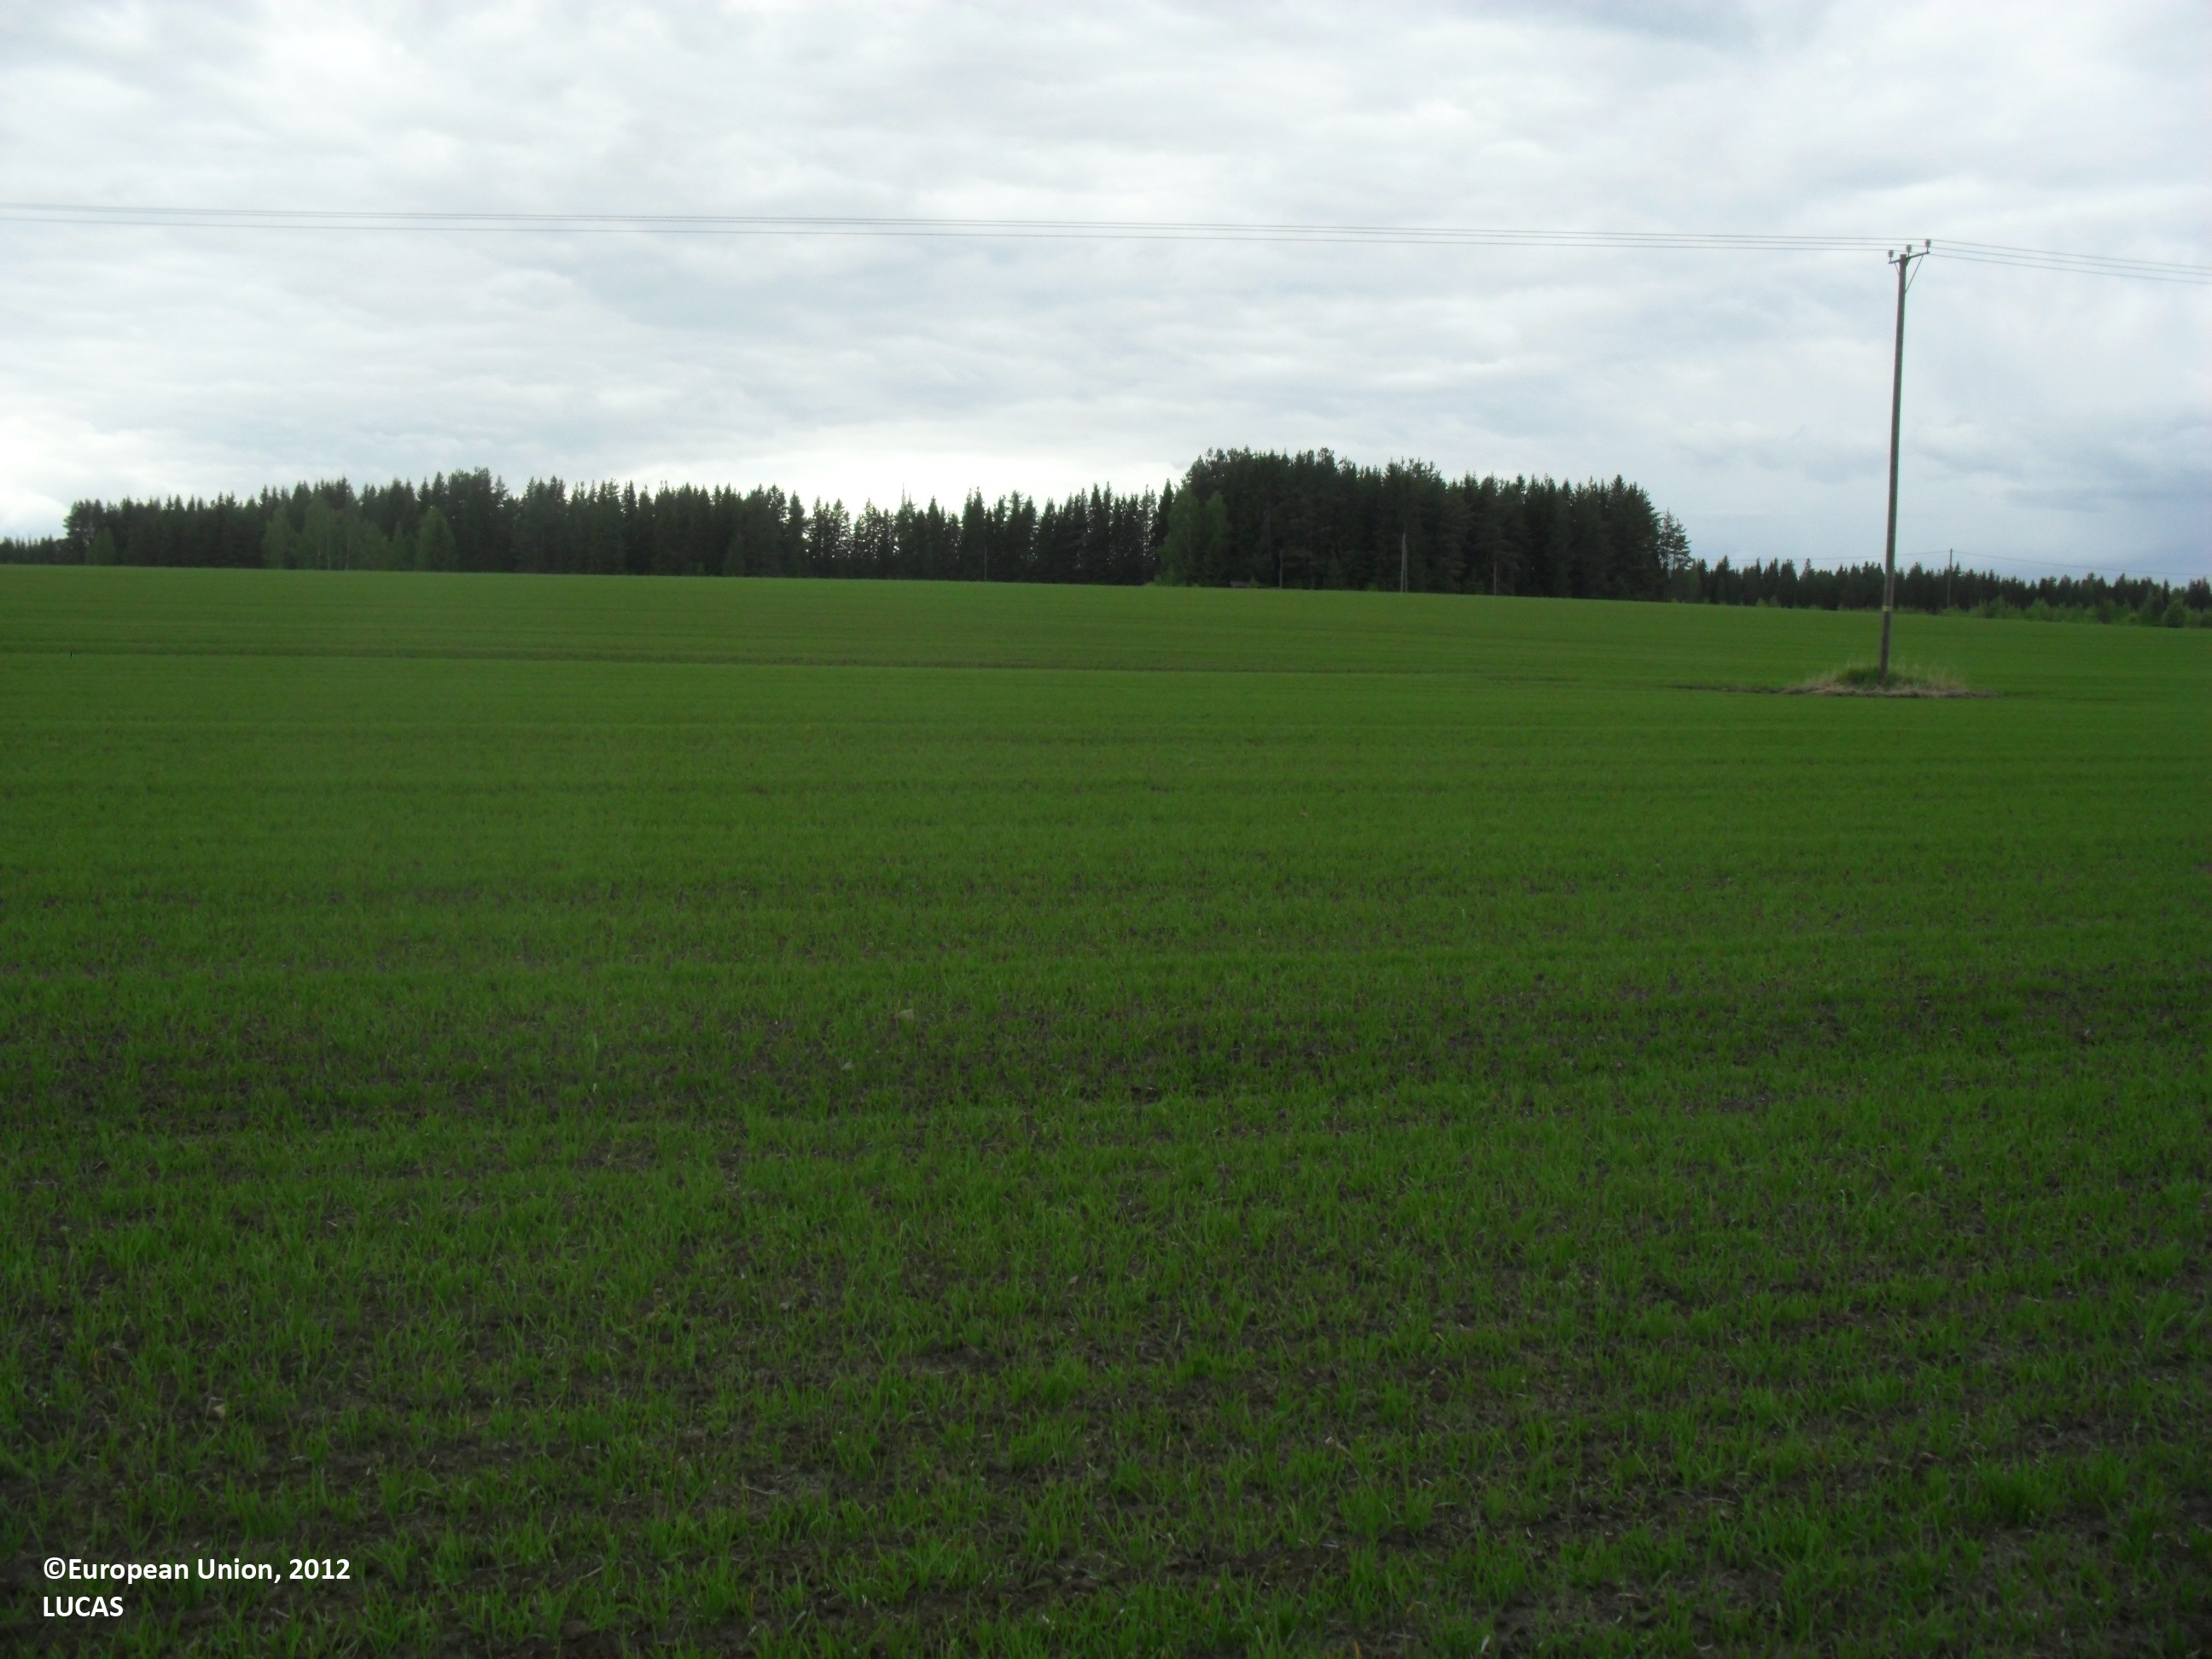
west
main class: Cropland
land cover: Oats
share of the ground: < 10 %
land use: Agriculture (excluding fallow land and kitchen gardens)
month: June
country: FI
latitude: 62.9256
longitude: 22.9980
